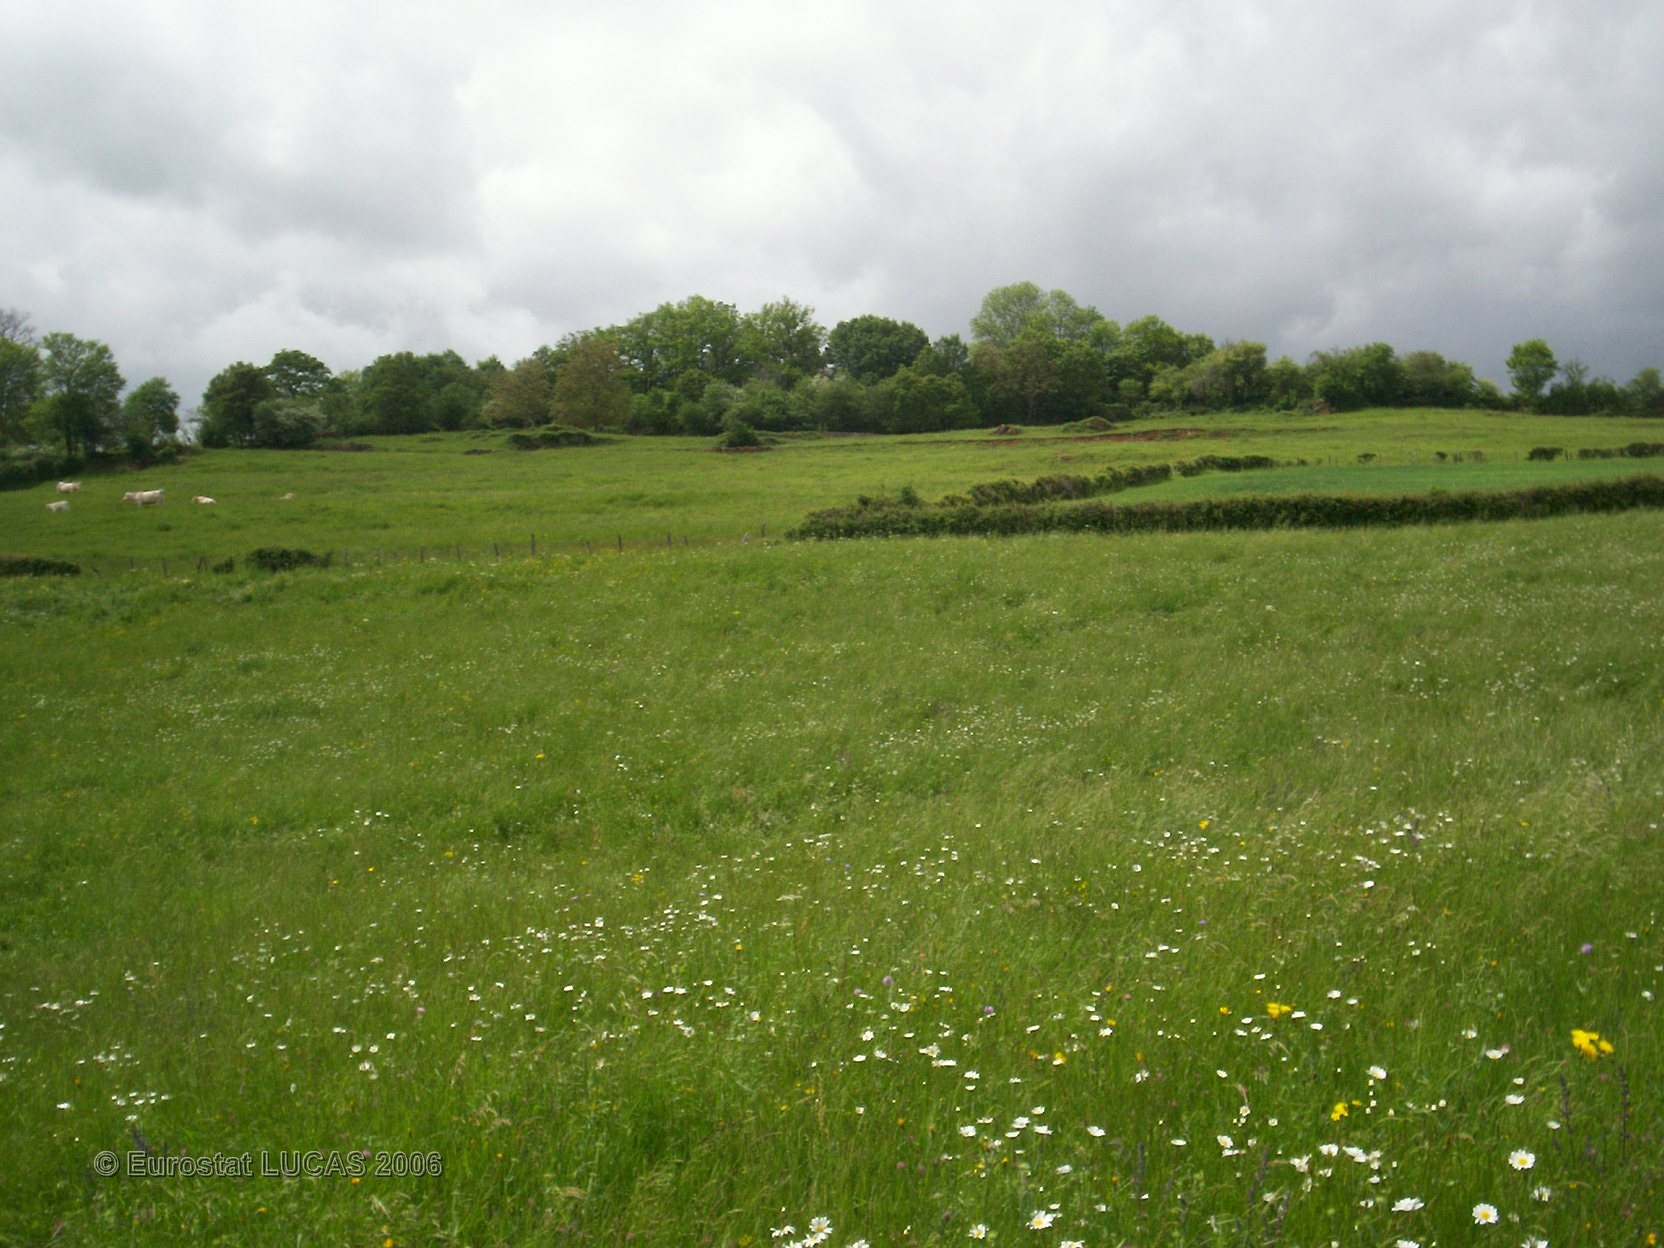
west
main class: Grassland
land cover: Grassland without tree/shrub cover
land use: Agriculture (excluding fallow land and kitchen gardens)
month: May
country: FR
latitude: 47.1382
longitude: 4.6602
